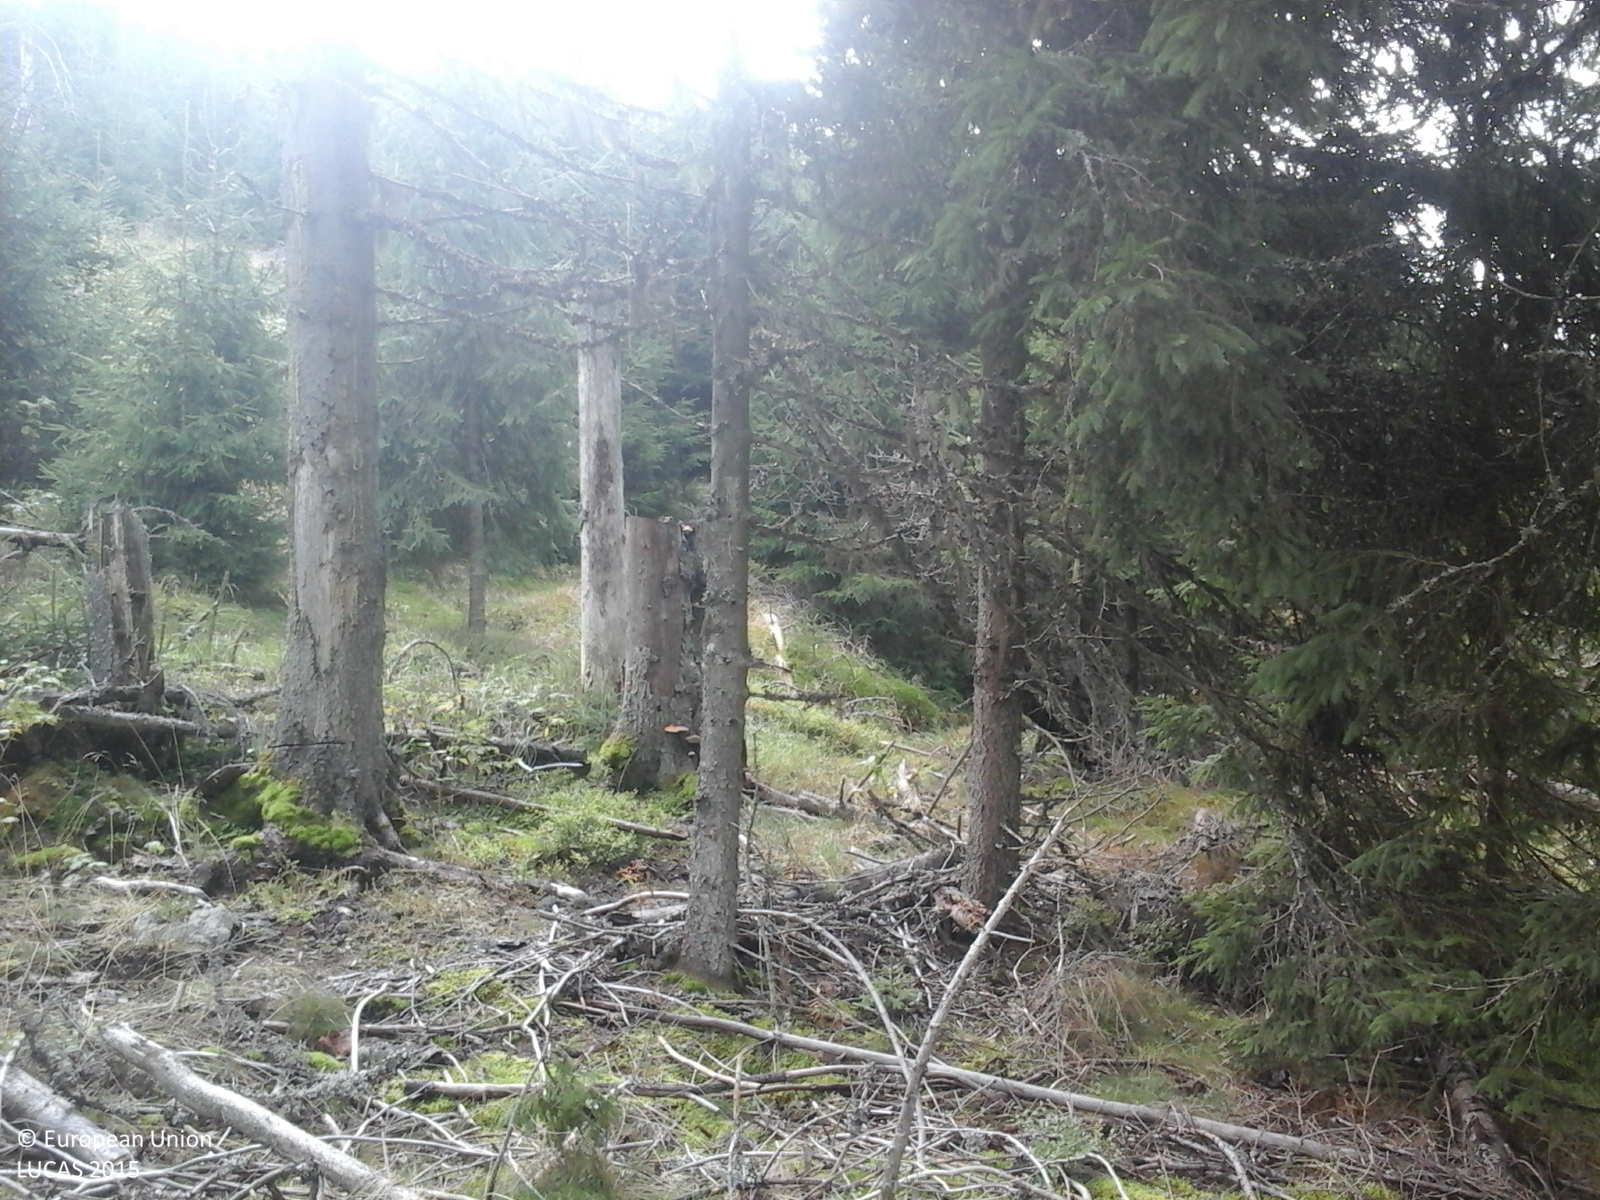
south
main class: Woodland
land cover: Spruce dominated coniferous woodland
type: alpine coniferous forest
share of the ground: > 75 %
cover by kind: coniferous forest trees 100 %
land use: Forestry
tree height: > 5 m
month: September
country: RO
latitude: 46.5344
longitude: 23.0333
